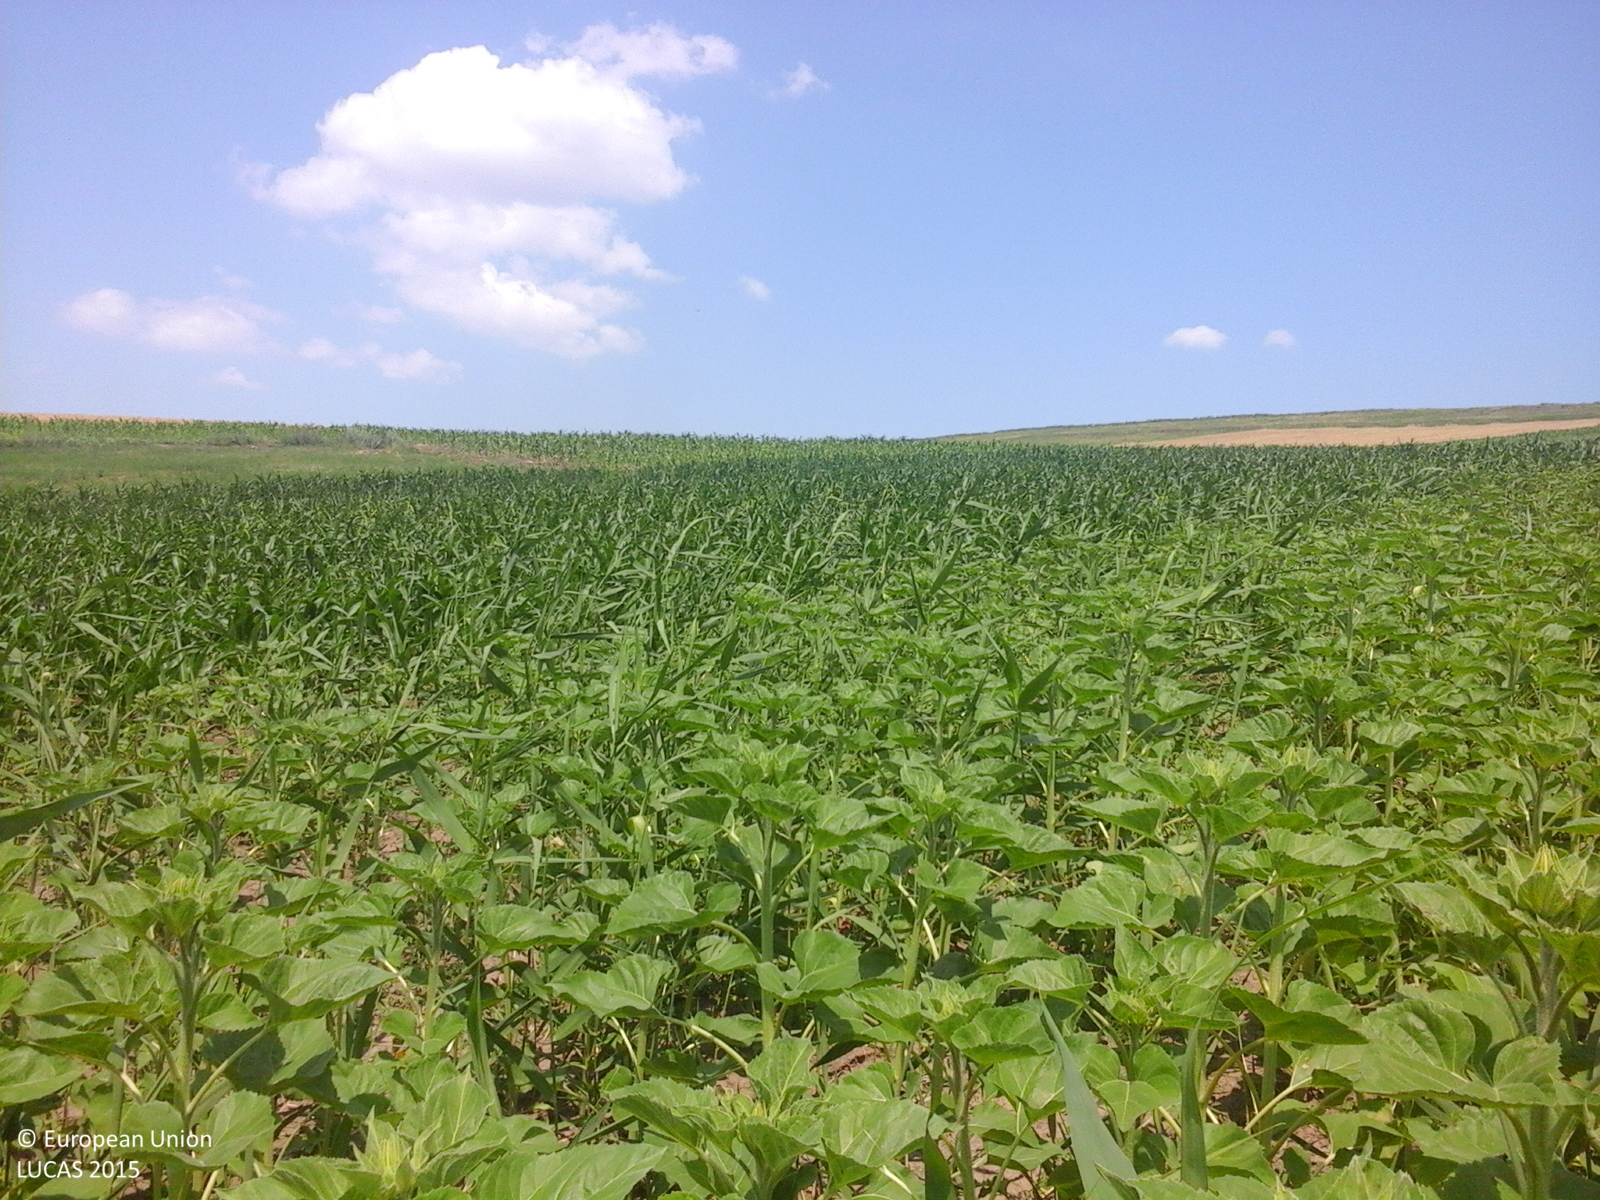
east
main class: Cropland
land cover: Sunflower
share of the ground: > 75 %
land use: Agriculture (excluding fallow land and kitchen gardens)
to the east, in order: Sunflower
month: June
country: RO
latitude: 47.2516
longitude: 27.3824
